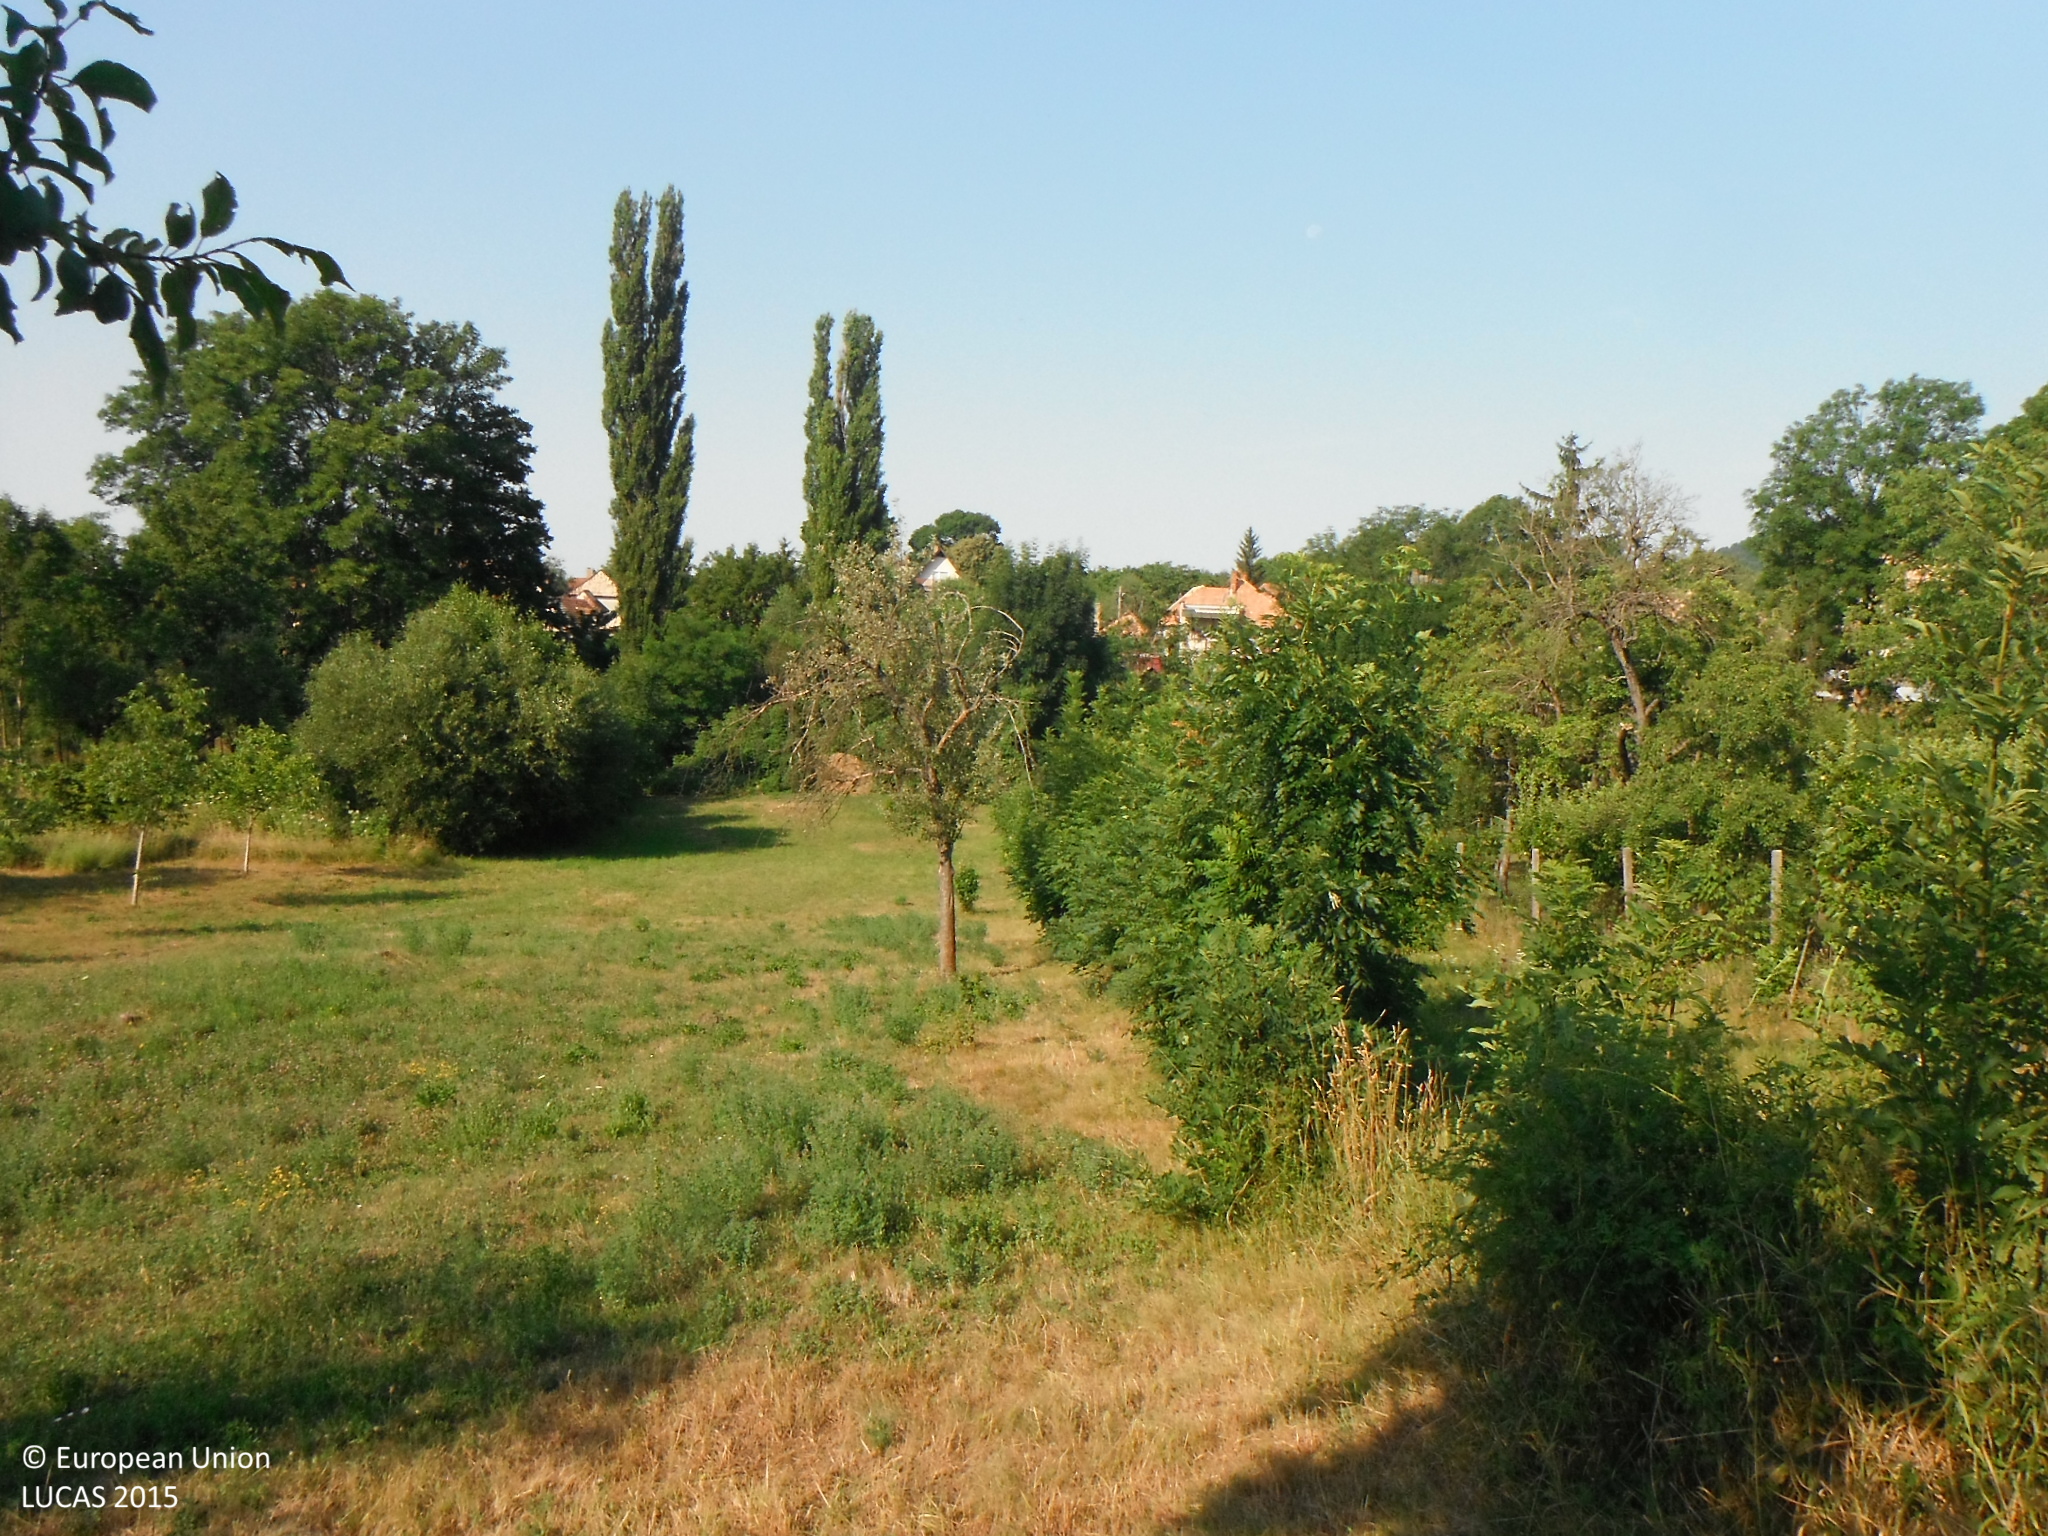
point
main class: Grassland
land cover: Grassland without tree/shrub cover
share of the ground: > 75 %
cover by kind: herbaceous plants 100 %
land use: Residential
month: July
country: SK
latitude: 48.1949
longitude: 19.2643
